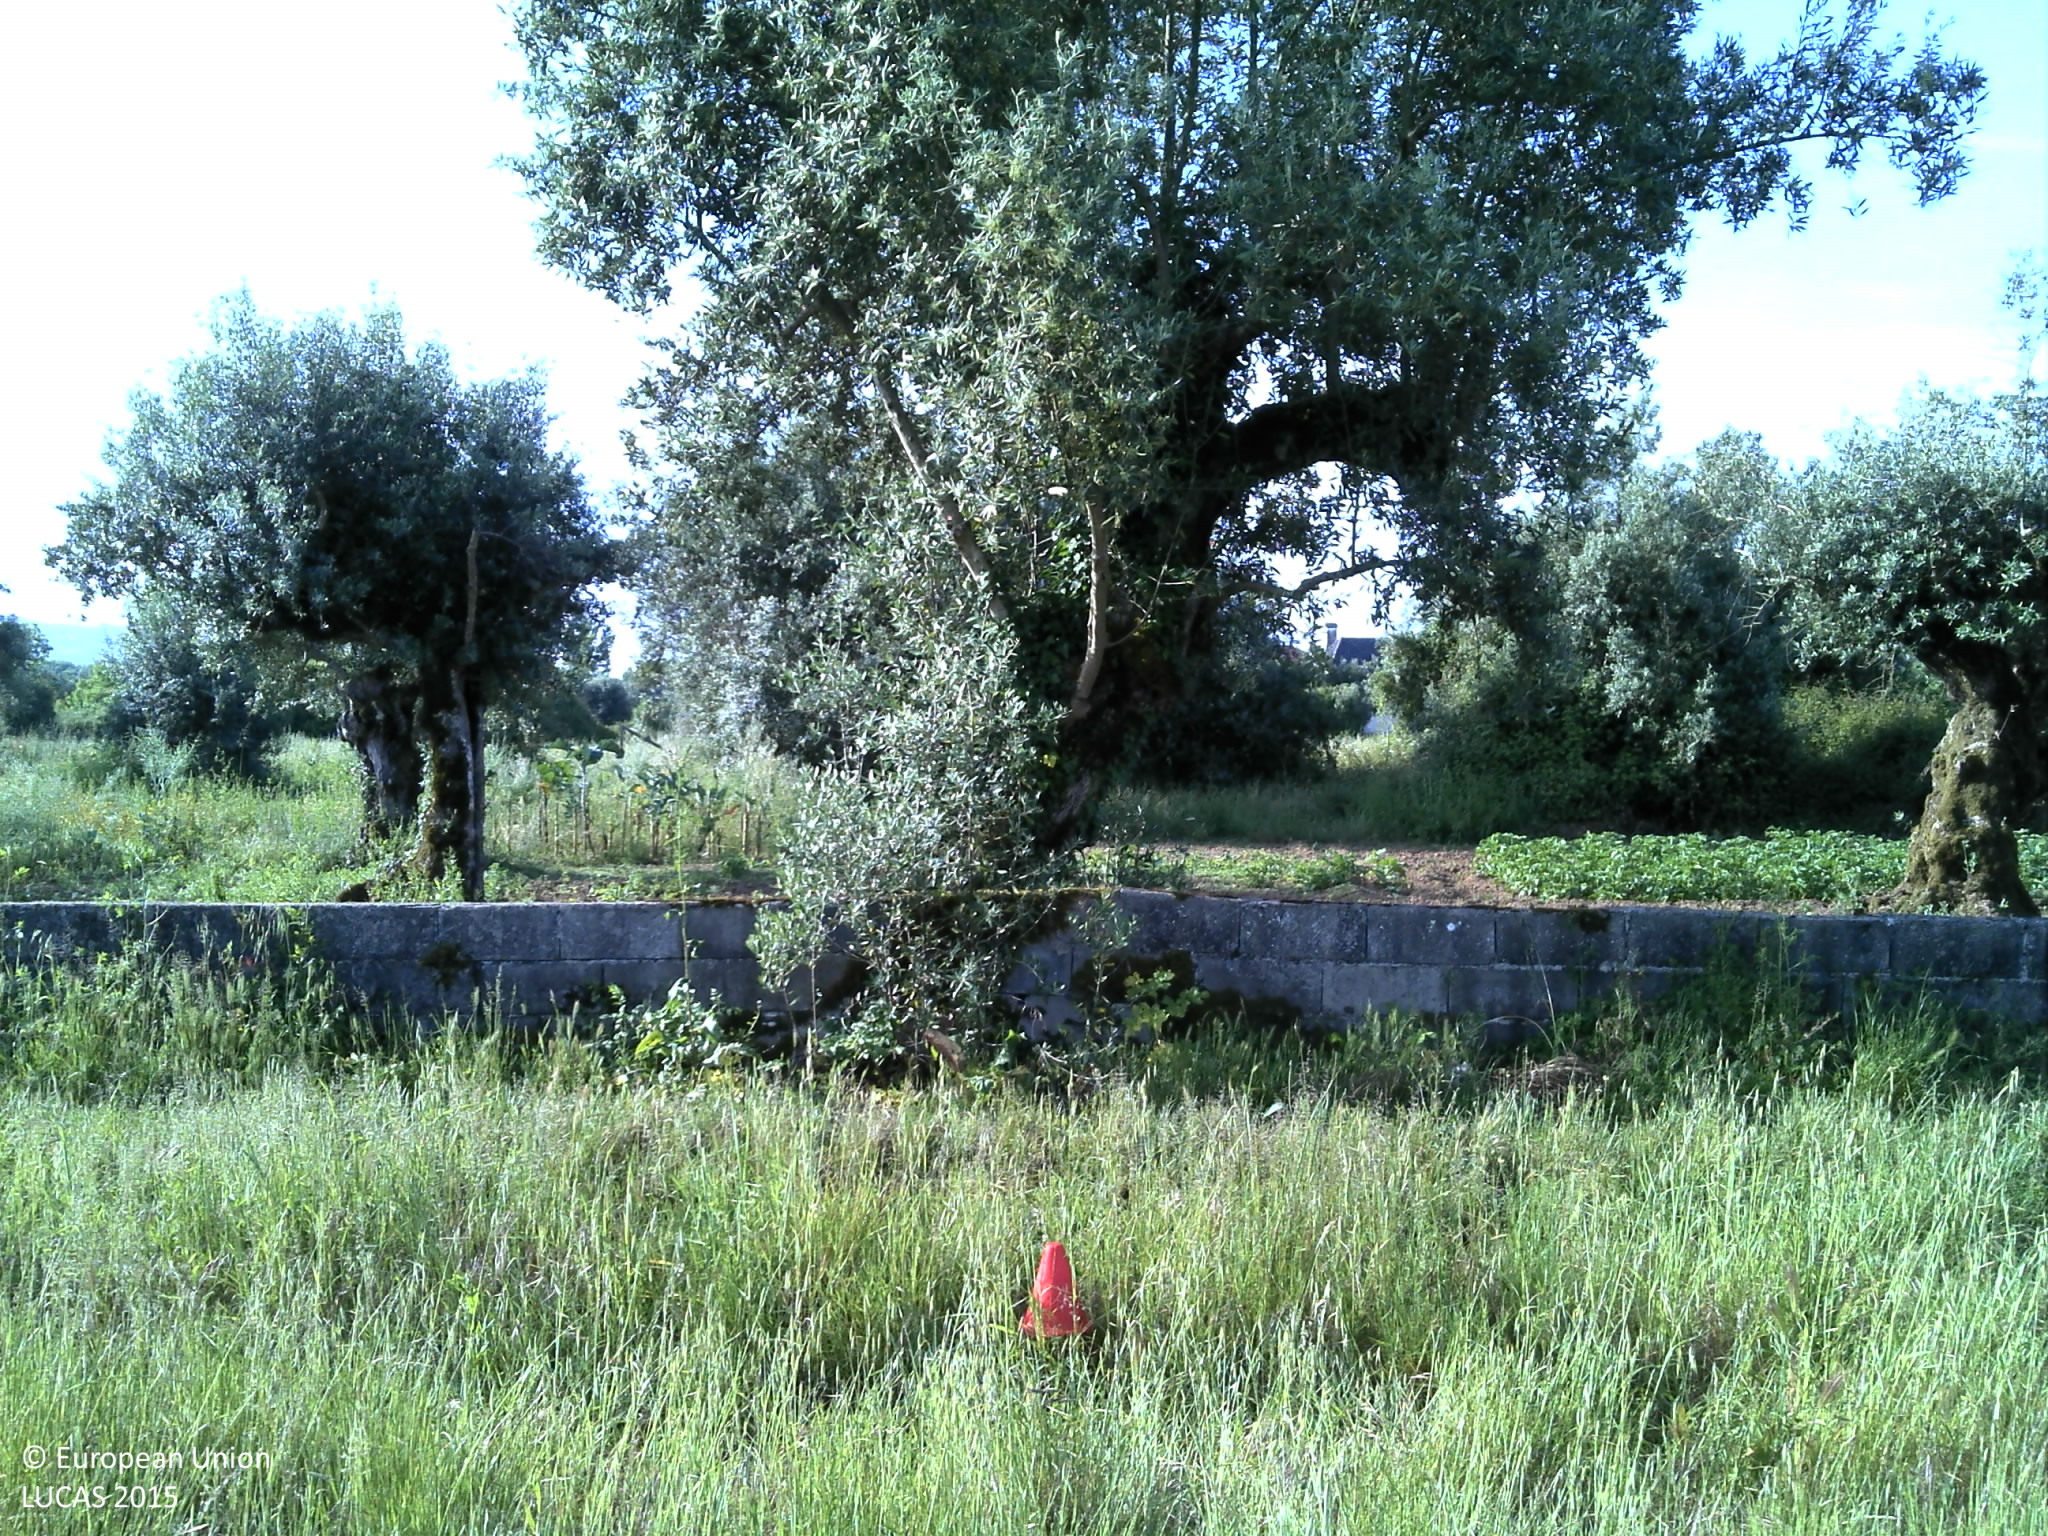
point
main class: Cropland
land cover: Oats
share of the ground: > 75 %
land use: Agriculture (excluding fallow land and kitchen gardens)
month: May
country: PT
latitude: 39.7740
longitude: -8.4646
